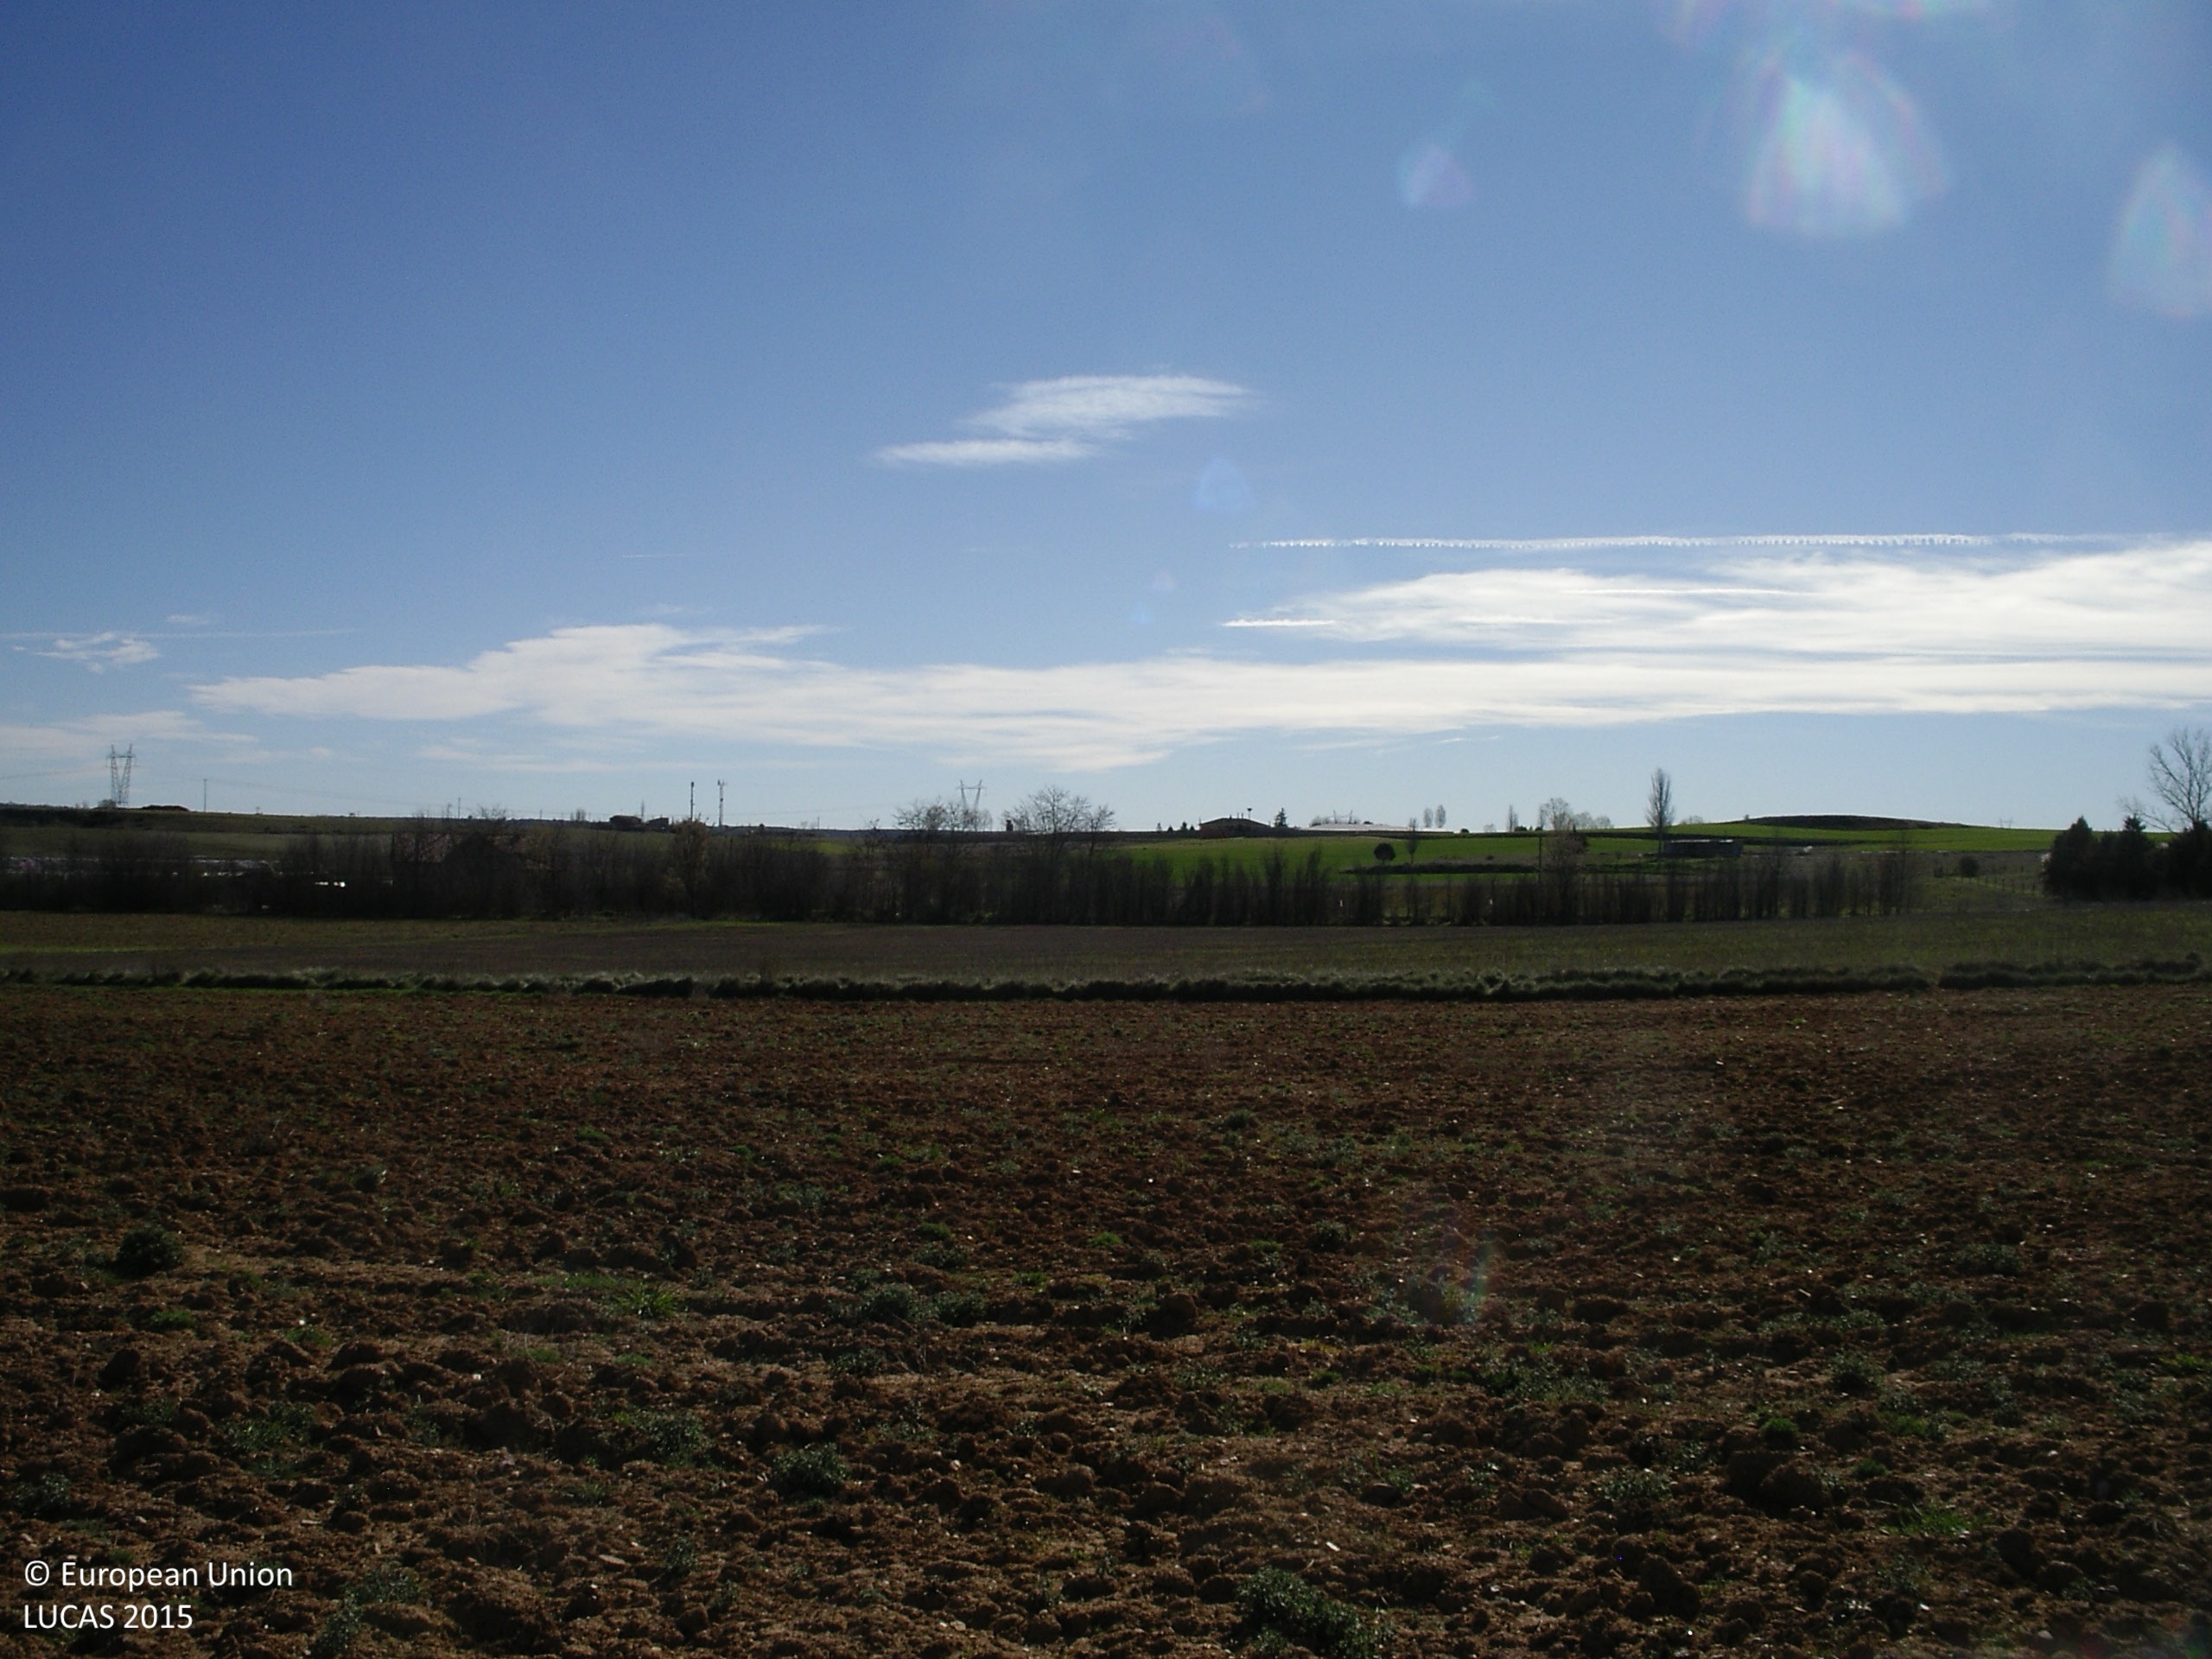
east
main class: Grassland
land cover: Spontaneously vegetated surfaces
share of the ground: > 75 %
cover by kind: consolidated bare surface 60 %, herbaceous plants 40 %
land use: Fallow land
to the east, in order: Spontaneously vegetated surfaces; Grass margins; Grassland without tree/shrub cover; Abandoned hedges; Electric lines; Abandoned hedges; Grass margins; Paved roads, cycling and walking lanes; Grass margins; Groves; Grassland without tree/shrub cover; Broadleaved woodland; Spontaneously vegetated surfaces
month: March
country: ES
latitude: 42.4454
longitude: -6.0694
